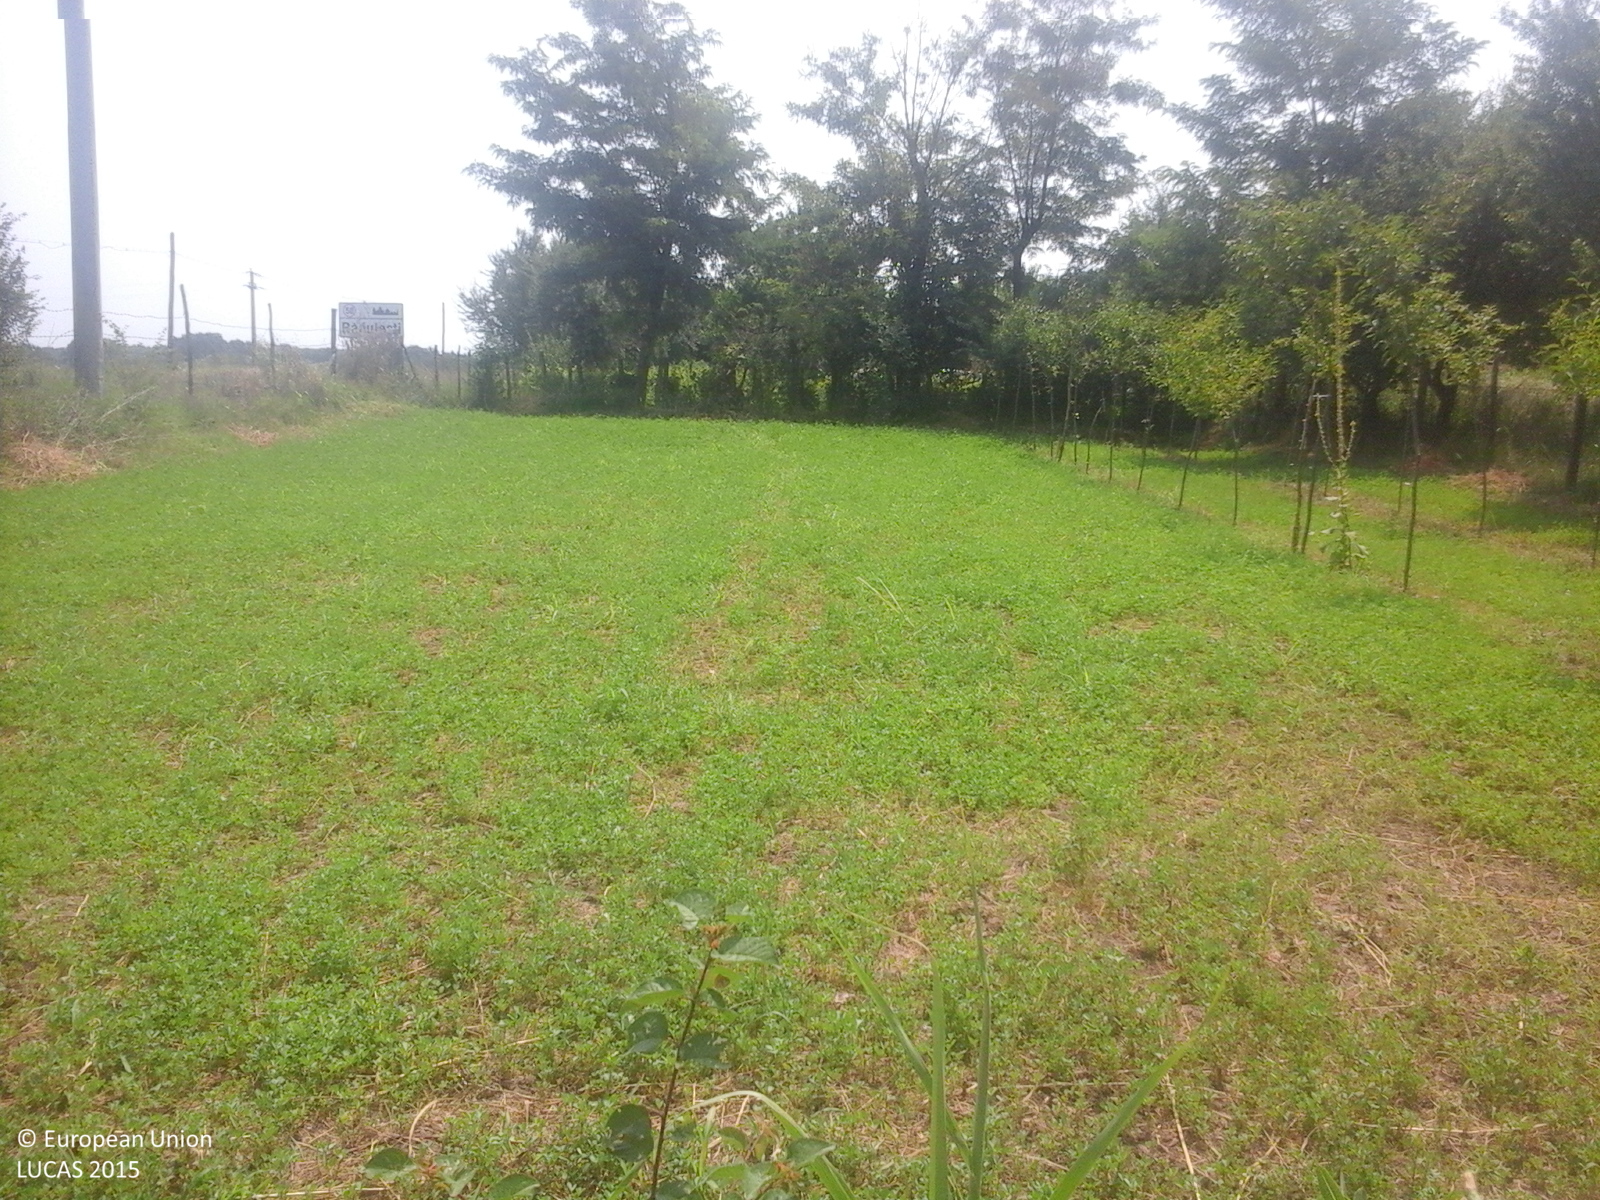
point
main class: Cropland
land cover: Lucerne
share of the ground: > 75 %
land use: Agriculture (excluding fallow land and kitchen gardens)
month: July
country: RO
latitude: 44.7698
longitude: 26.3511
